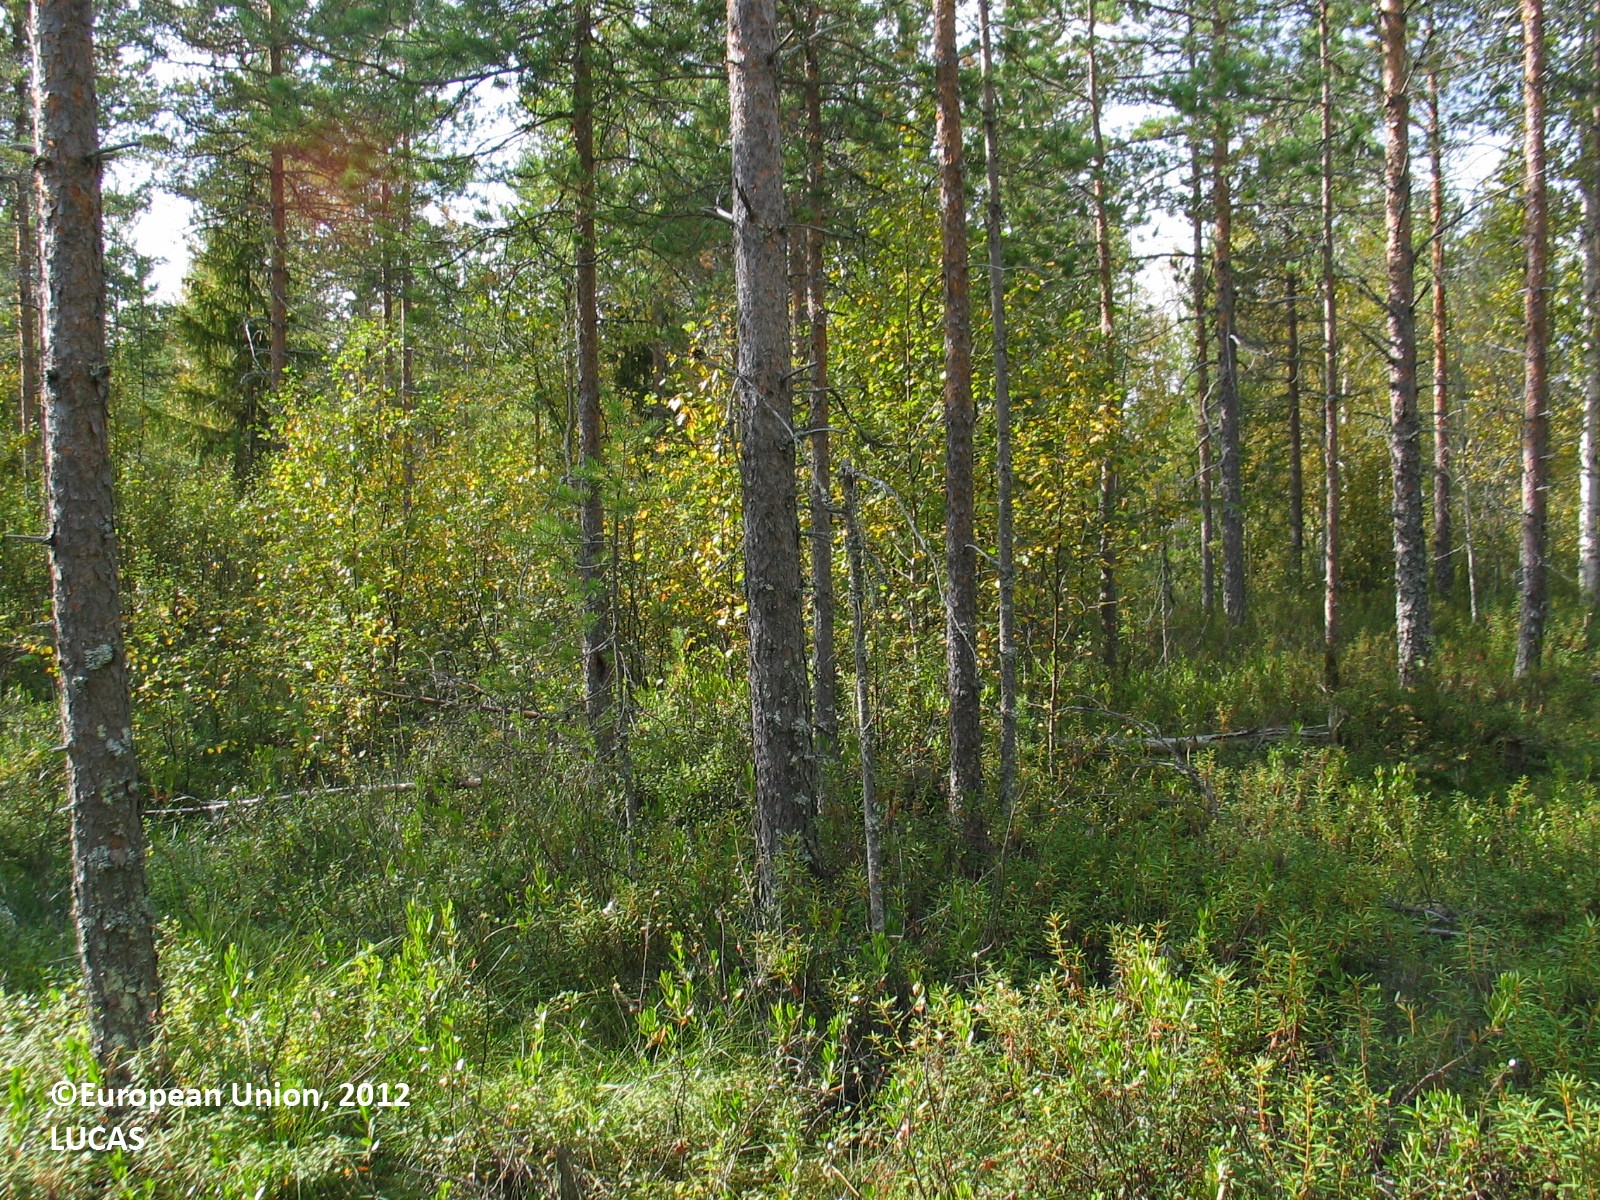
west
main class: Woodland
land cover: Pine dominated coniferous woodland
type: mire and swamp forests
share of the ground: 25 - 50 %
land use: Forestry
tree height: > 5 m
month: August
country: FI
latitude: 65.2394
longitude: 26.4300
